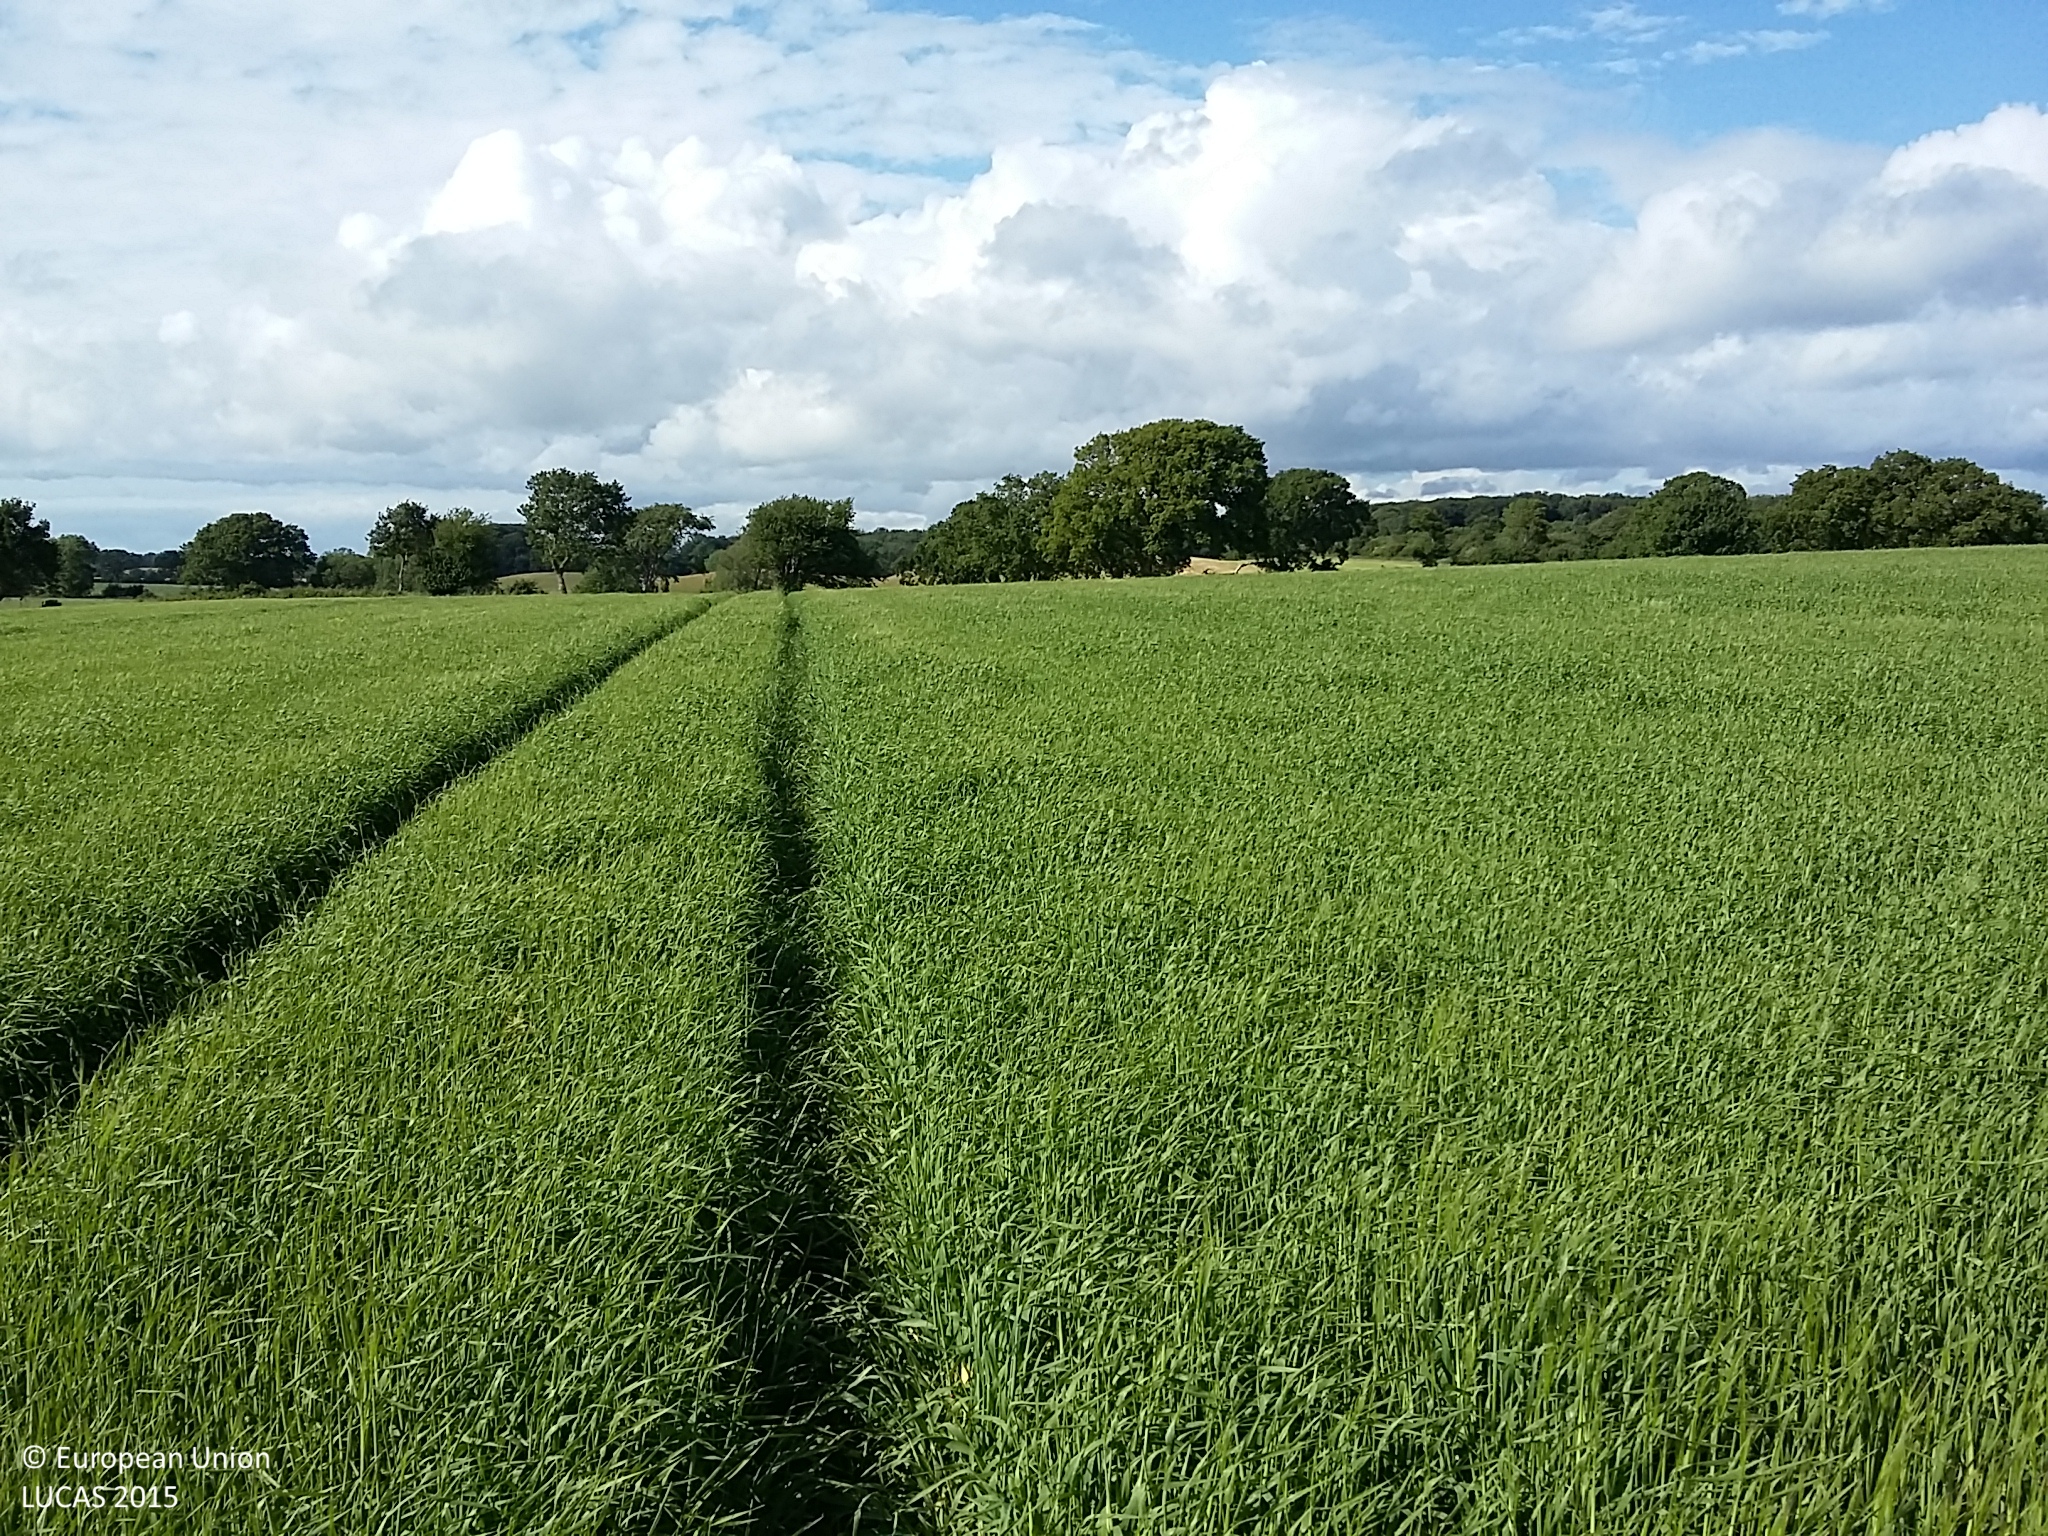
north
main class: Cropland
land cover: Barley
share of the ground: > 75 %
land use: Agriculture (excluding fallow land and kitchen gardens)
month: June
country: DK
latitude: 54.8374
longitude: 10.7624
